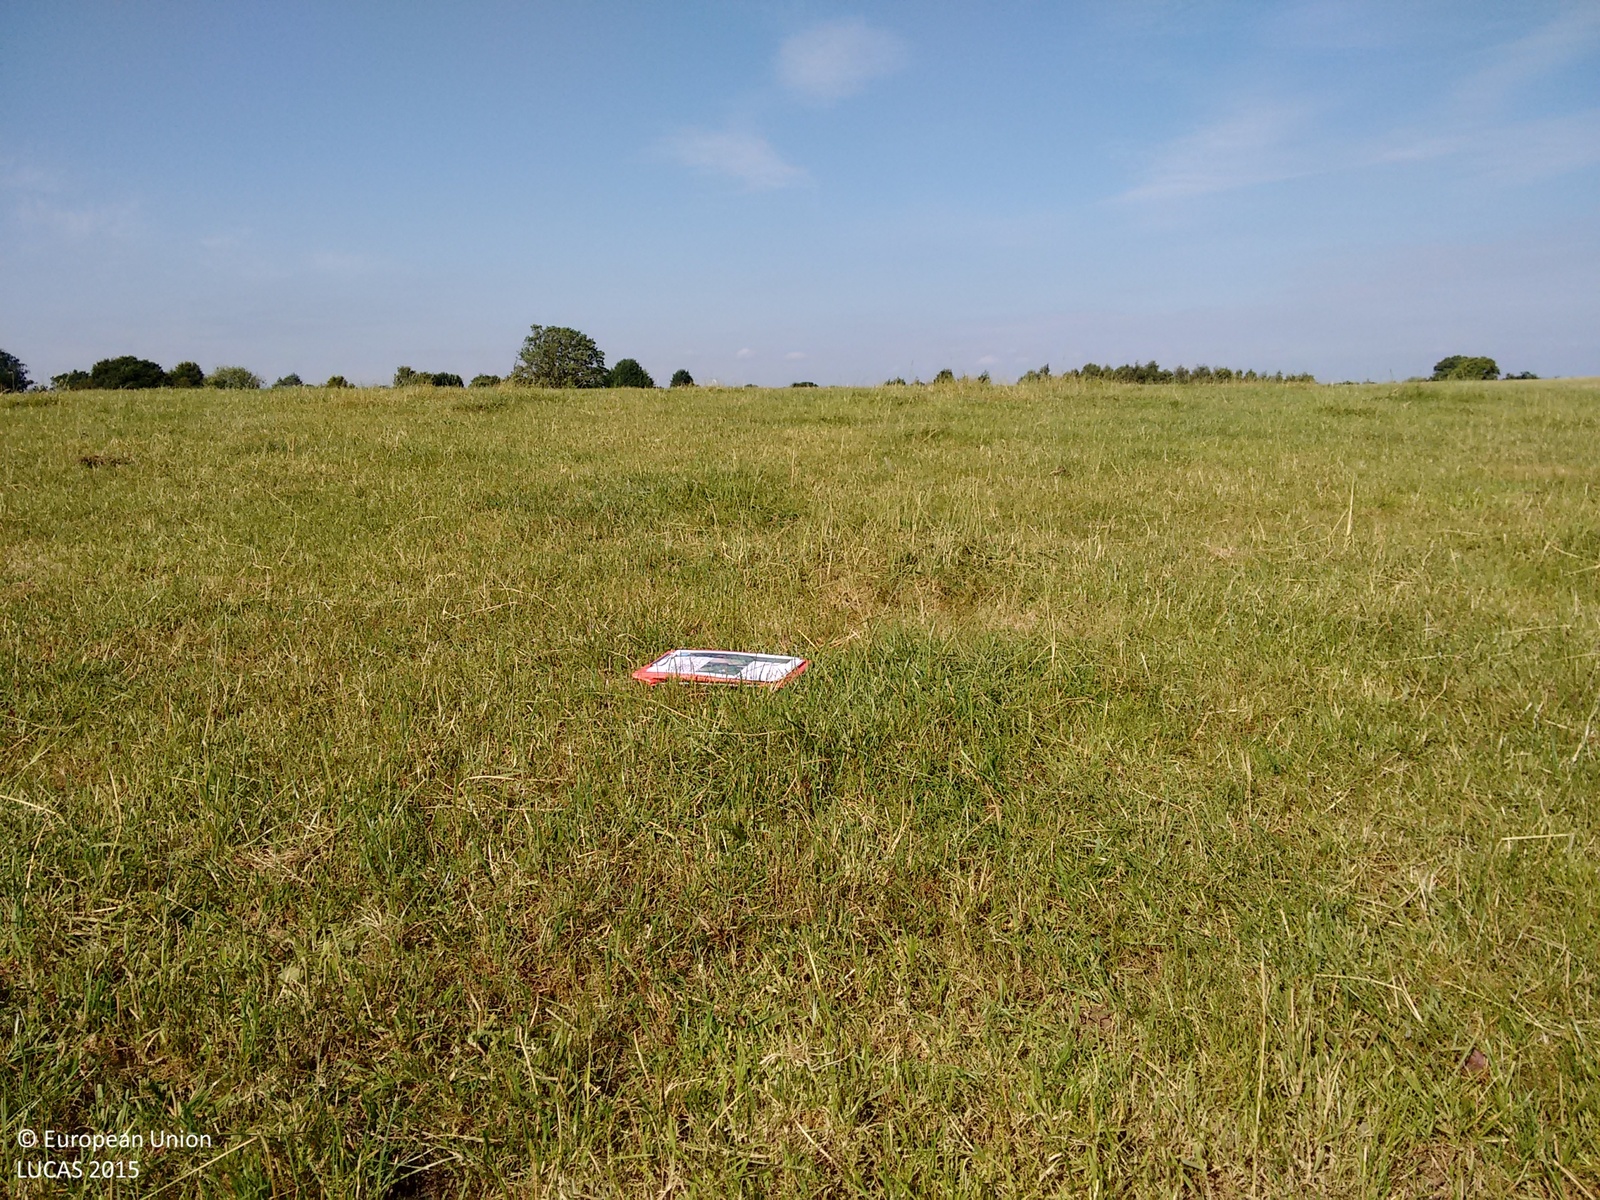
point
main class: Grassland
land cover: Grassland without tree/shrub cover
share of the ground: > 75 %
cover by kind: herbaceous plants 100 %
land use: Agriculture (excluding fallow land and kitchen gardens)
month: July
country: GB
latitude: 53.0287
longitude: -2.4558
